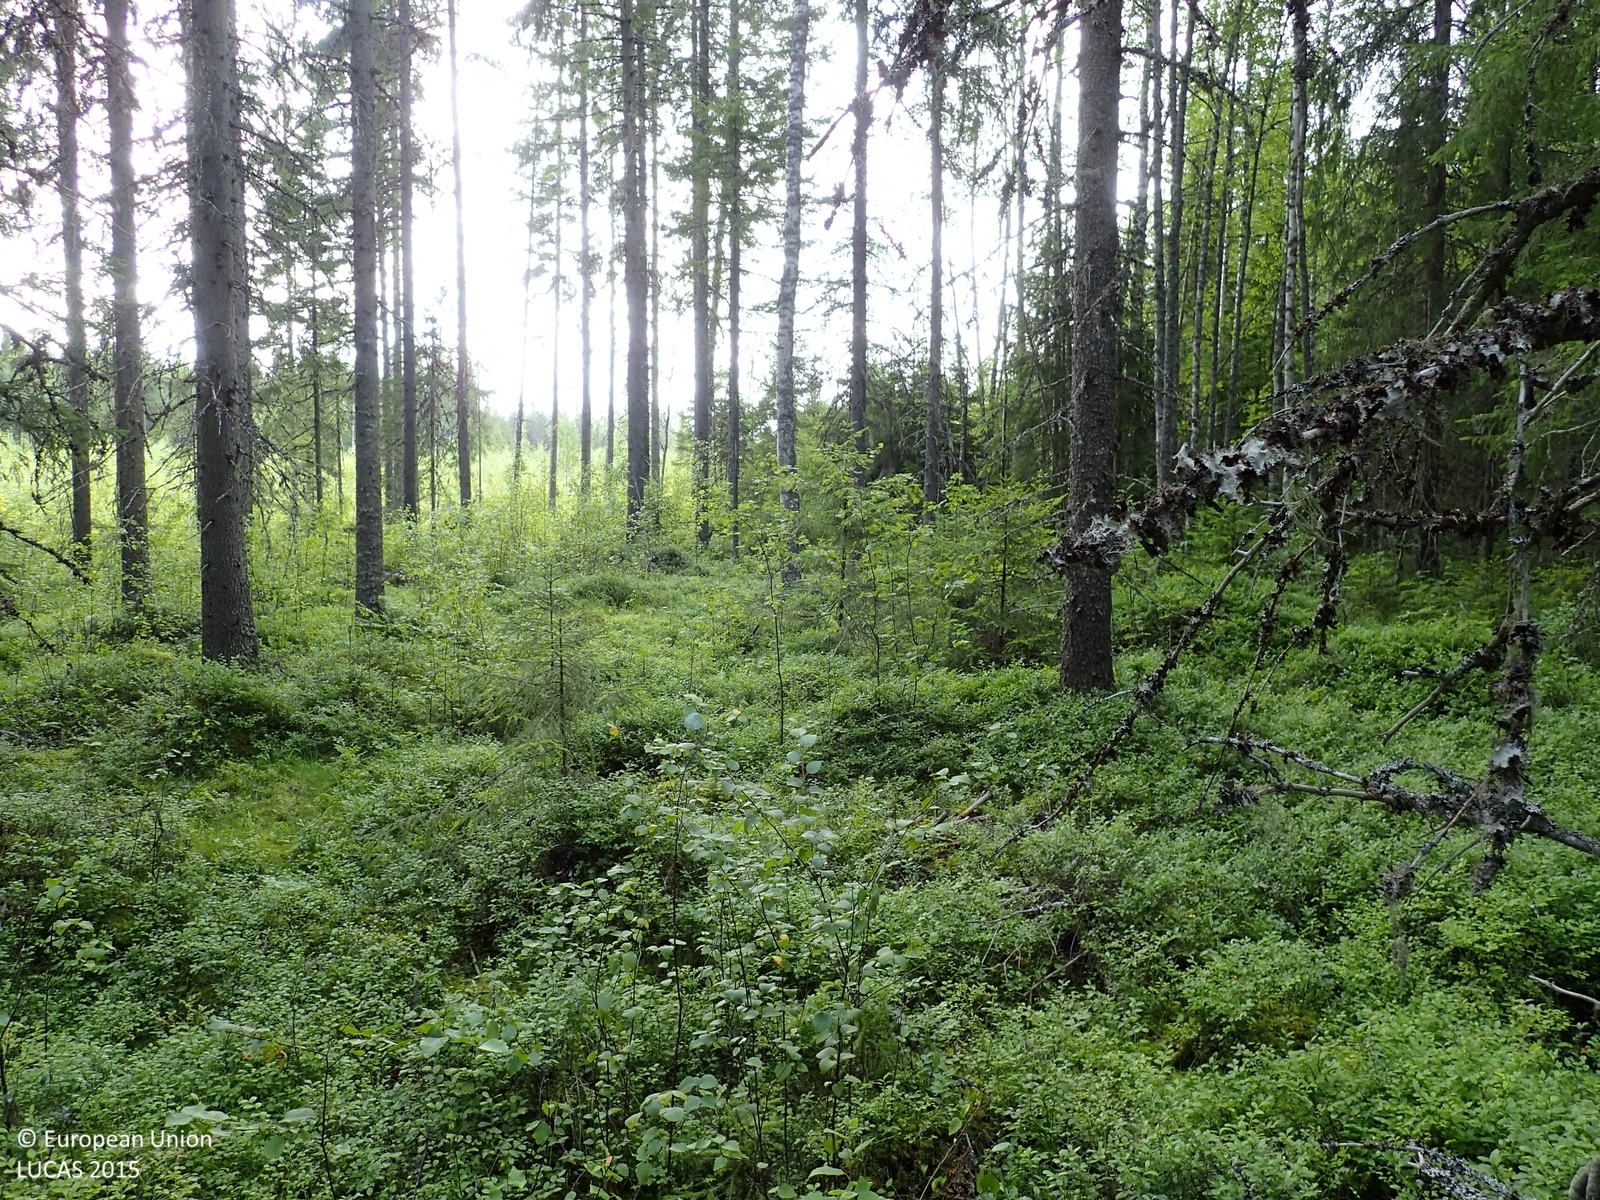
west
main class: Woodland
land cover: Spruce dominated coniferous woodland
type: boreal forest
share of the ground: > 75 %
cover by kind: coniferous forest trees 65 %, shrubs 20 %, broadleaved forest trees 10 %, lichens and mosses 5 %
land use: Forestry
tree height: > 5 m
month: August
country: FI
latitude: 62.7574
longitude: 21.9323
